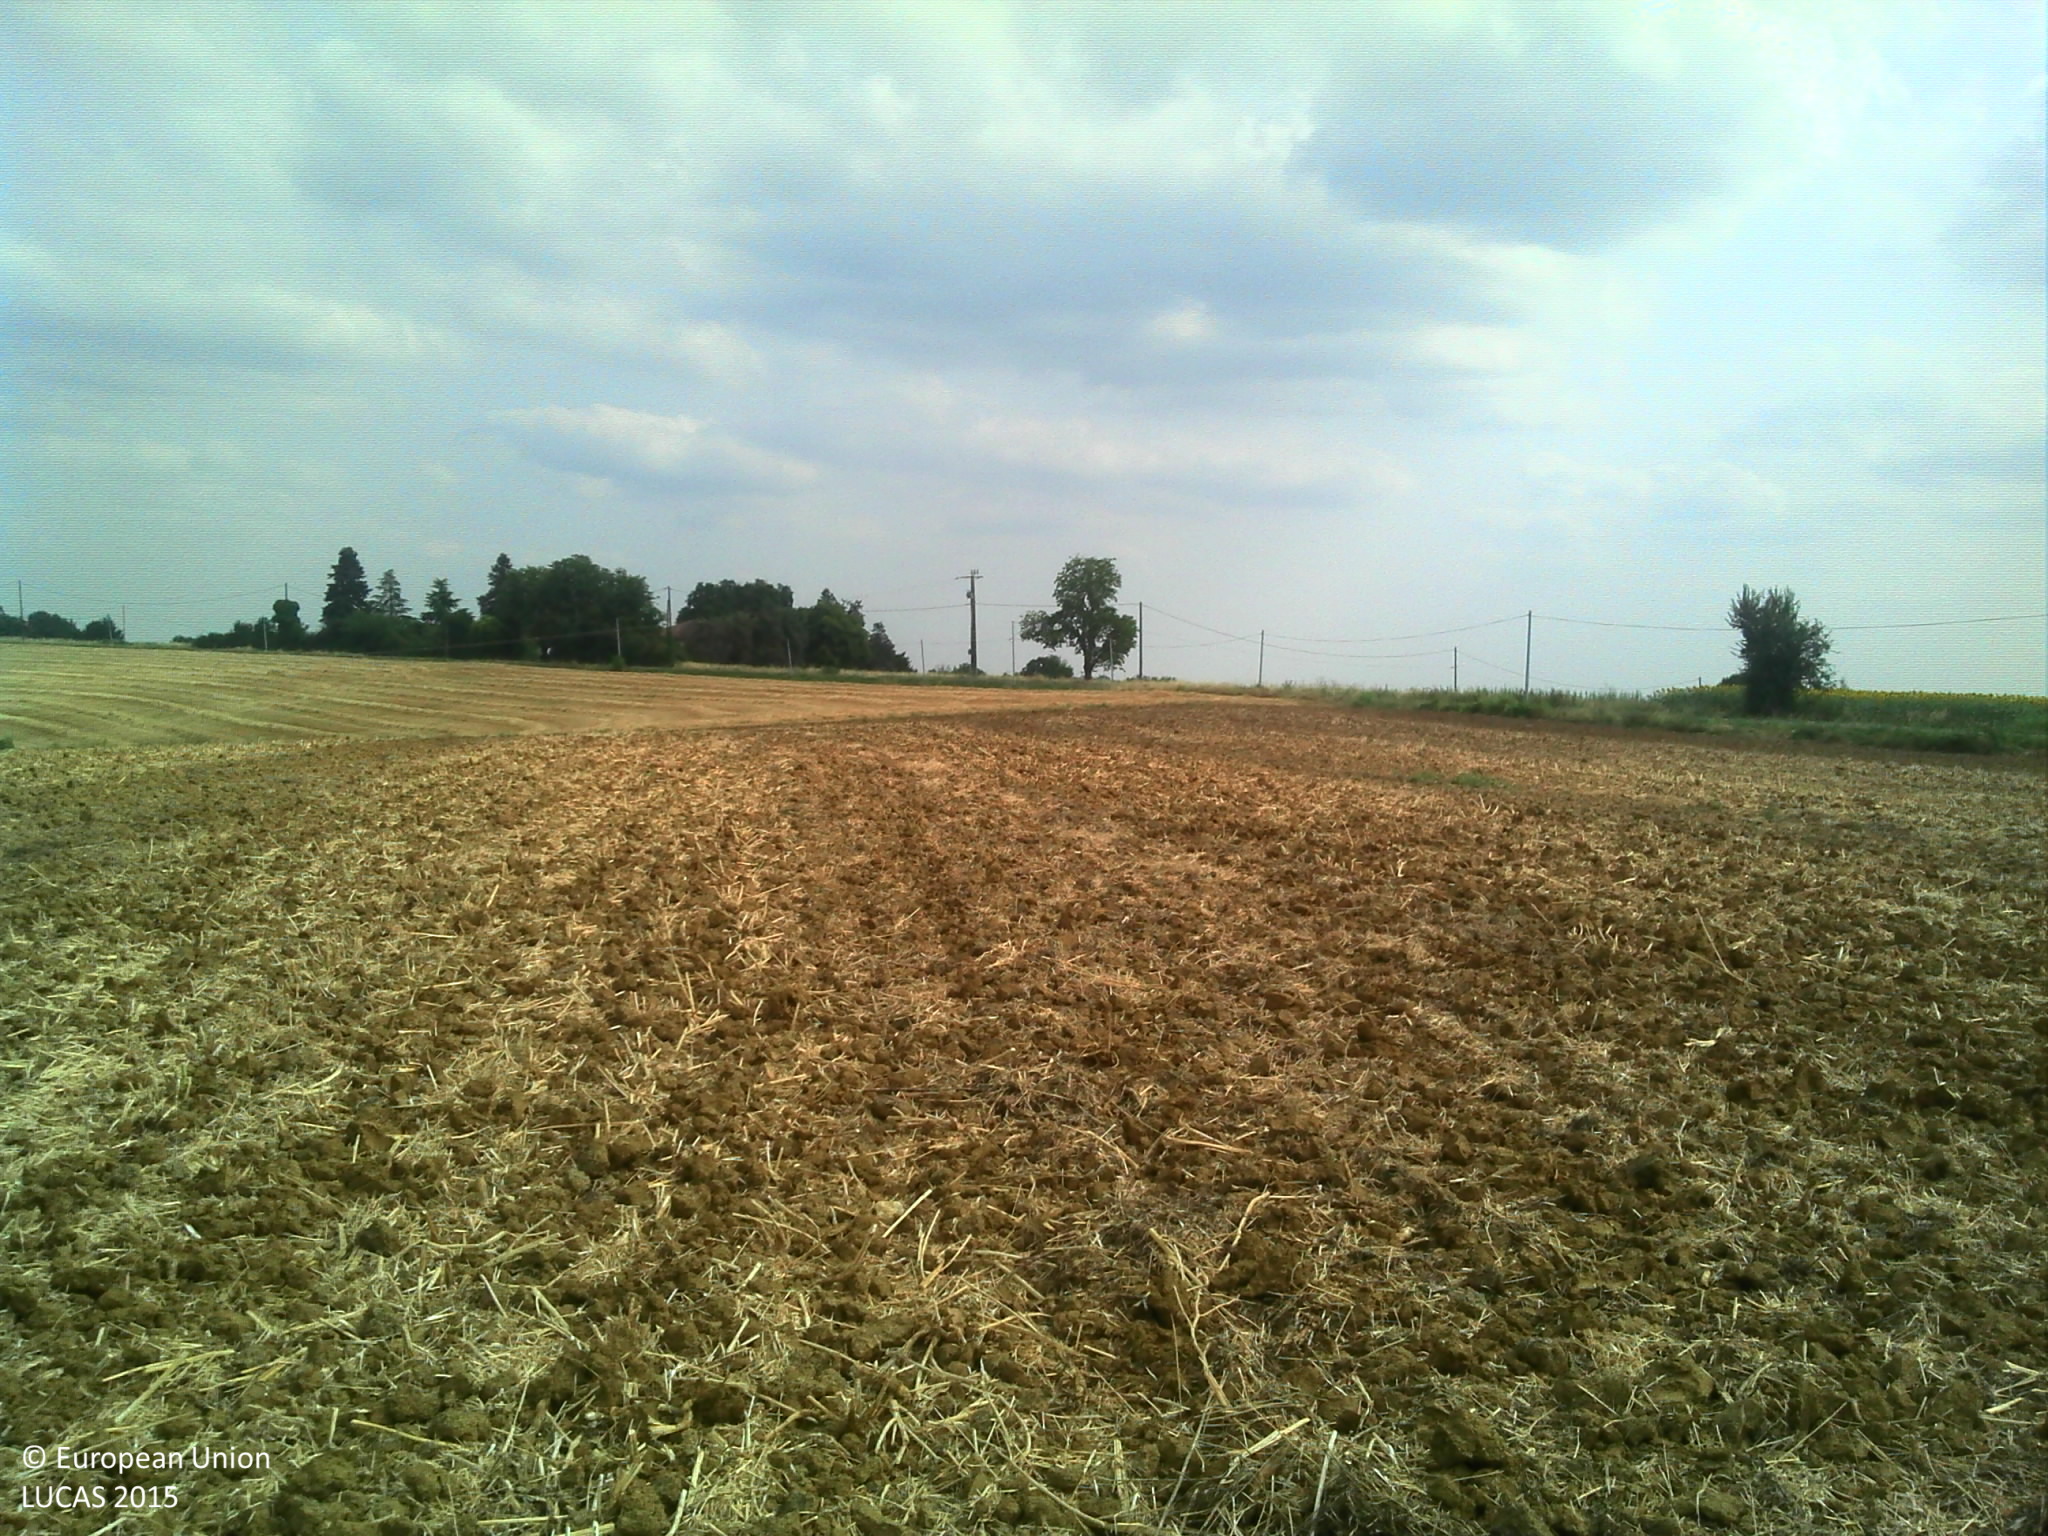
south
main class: Cropland
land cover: Rape and turnip rape
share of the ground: 10 - 25 %
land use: Agriculture (excluding fallow land and kitchen gardens)
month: July
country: FR
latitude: 44.2619
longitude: 0.9400
